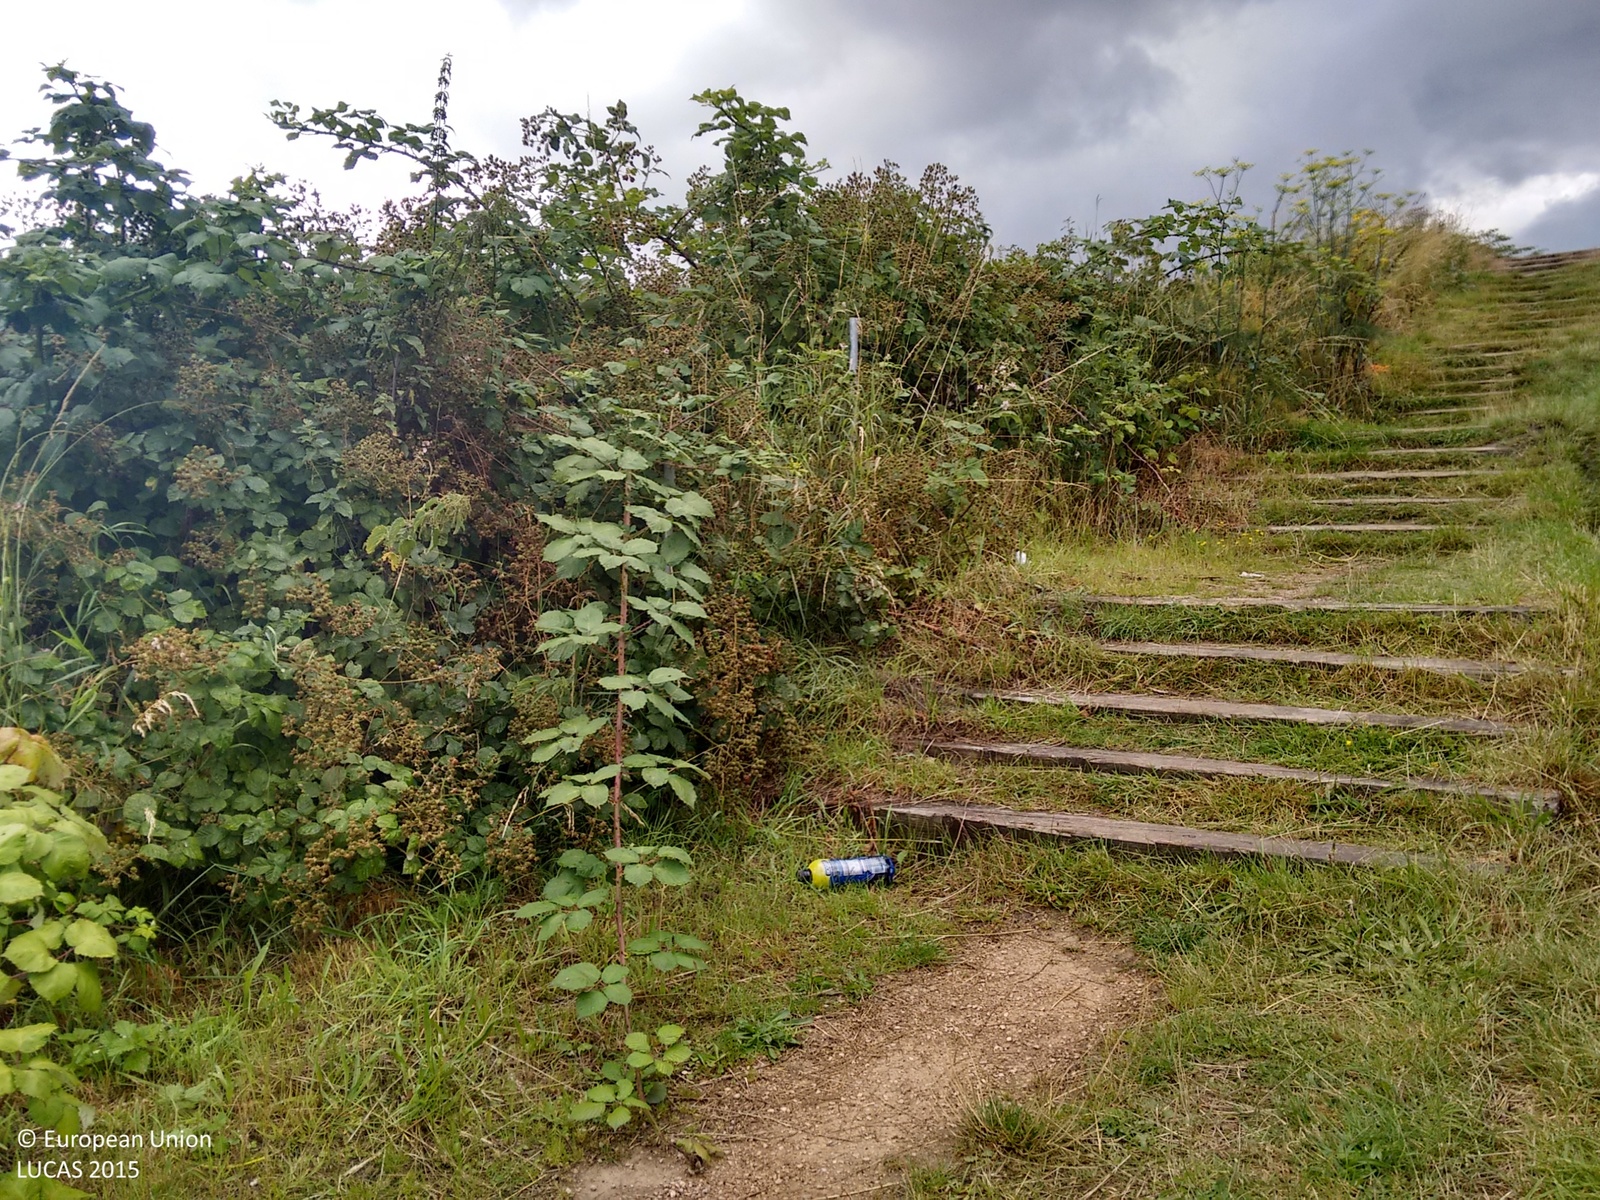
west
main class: Grassland
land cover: Grassland without tree/shrub cover
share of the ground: > 75 %
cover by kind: herbaceous plants 100 %
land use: Water transport
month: July
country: GB
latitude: 52.5491
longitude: -1.9886
